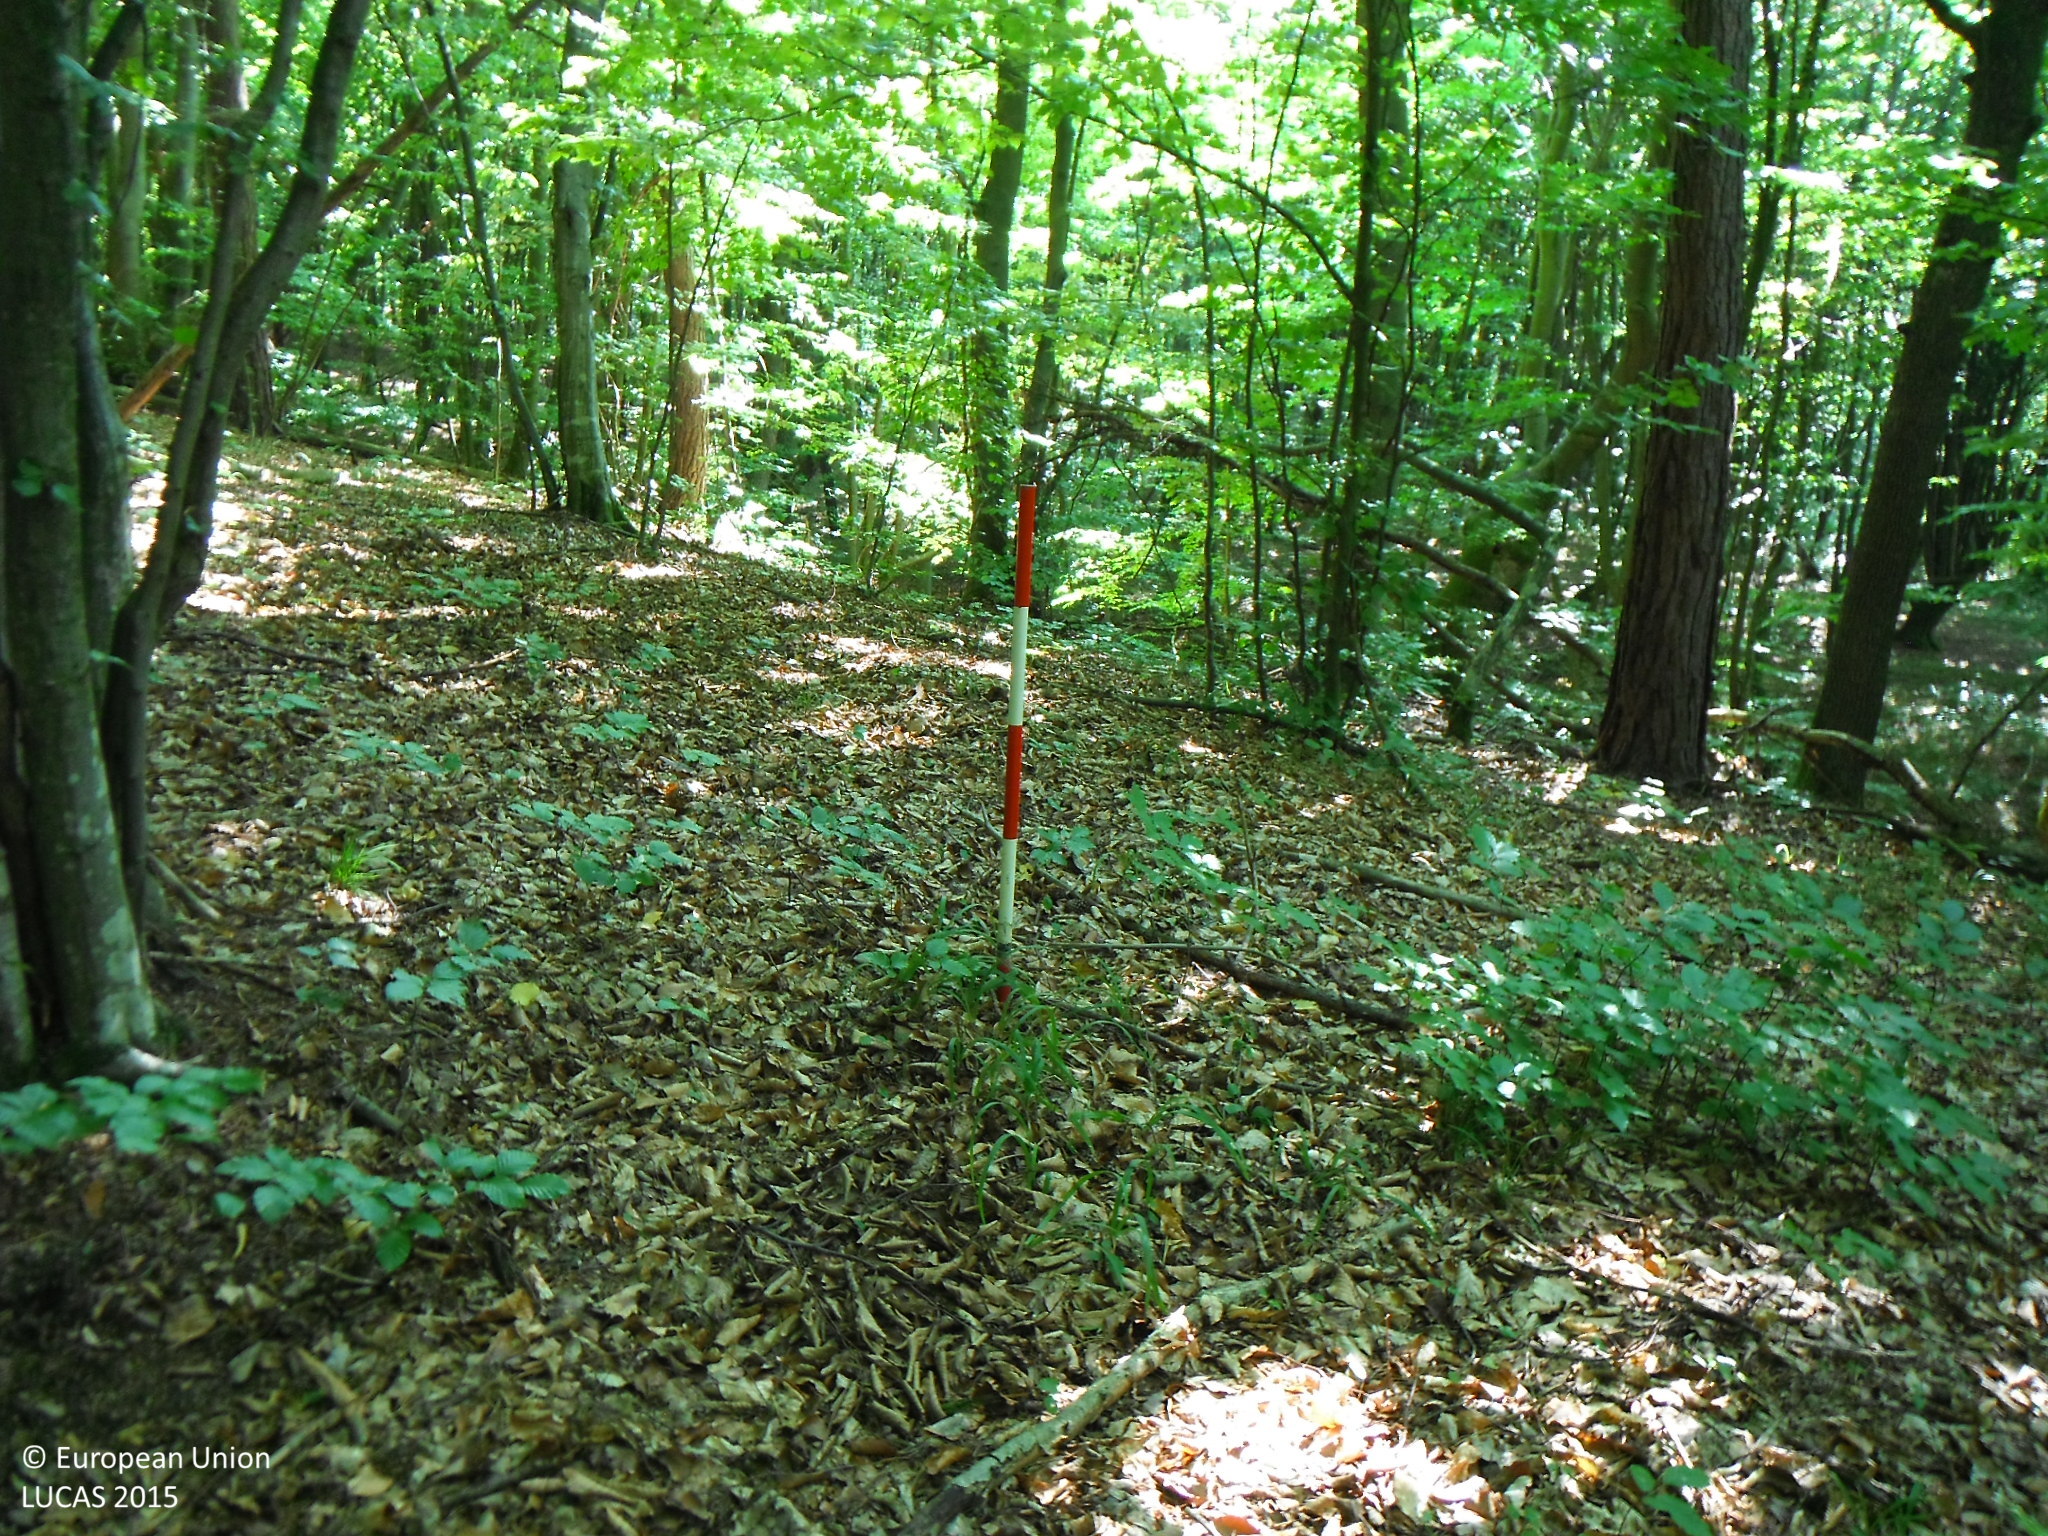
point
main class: Woodland
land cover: Broadleaved woodland
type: hemiboreal forest and nemoral coniferous forest and mixed broadleaved-coniferous forest
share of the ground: > 75 %
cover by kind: broadleaved forest trees 85 %, coniferous forest trees 15 %
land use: Forestry
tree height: > 5 m
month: August
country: SK
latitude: 49.1155
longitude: 21.9611
